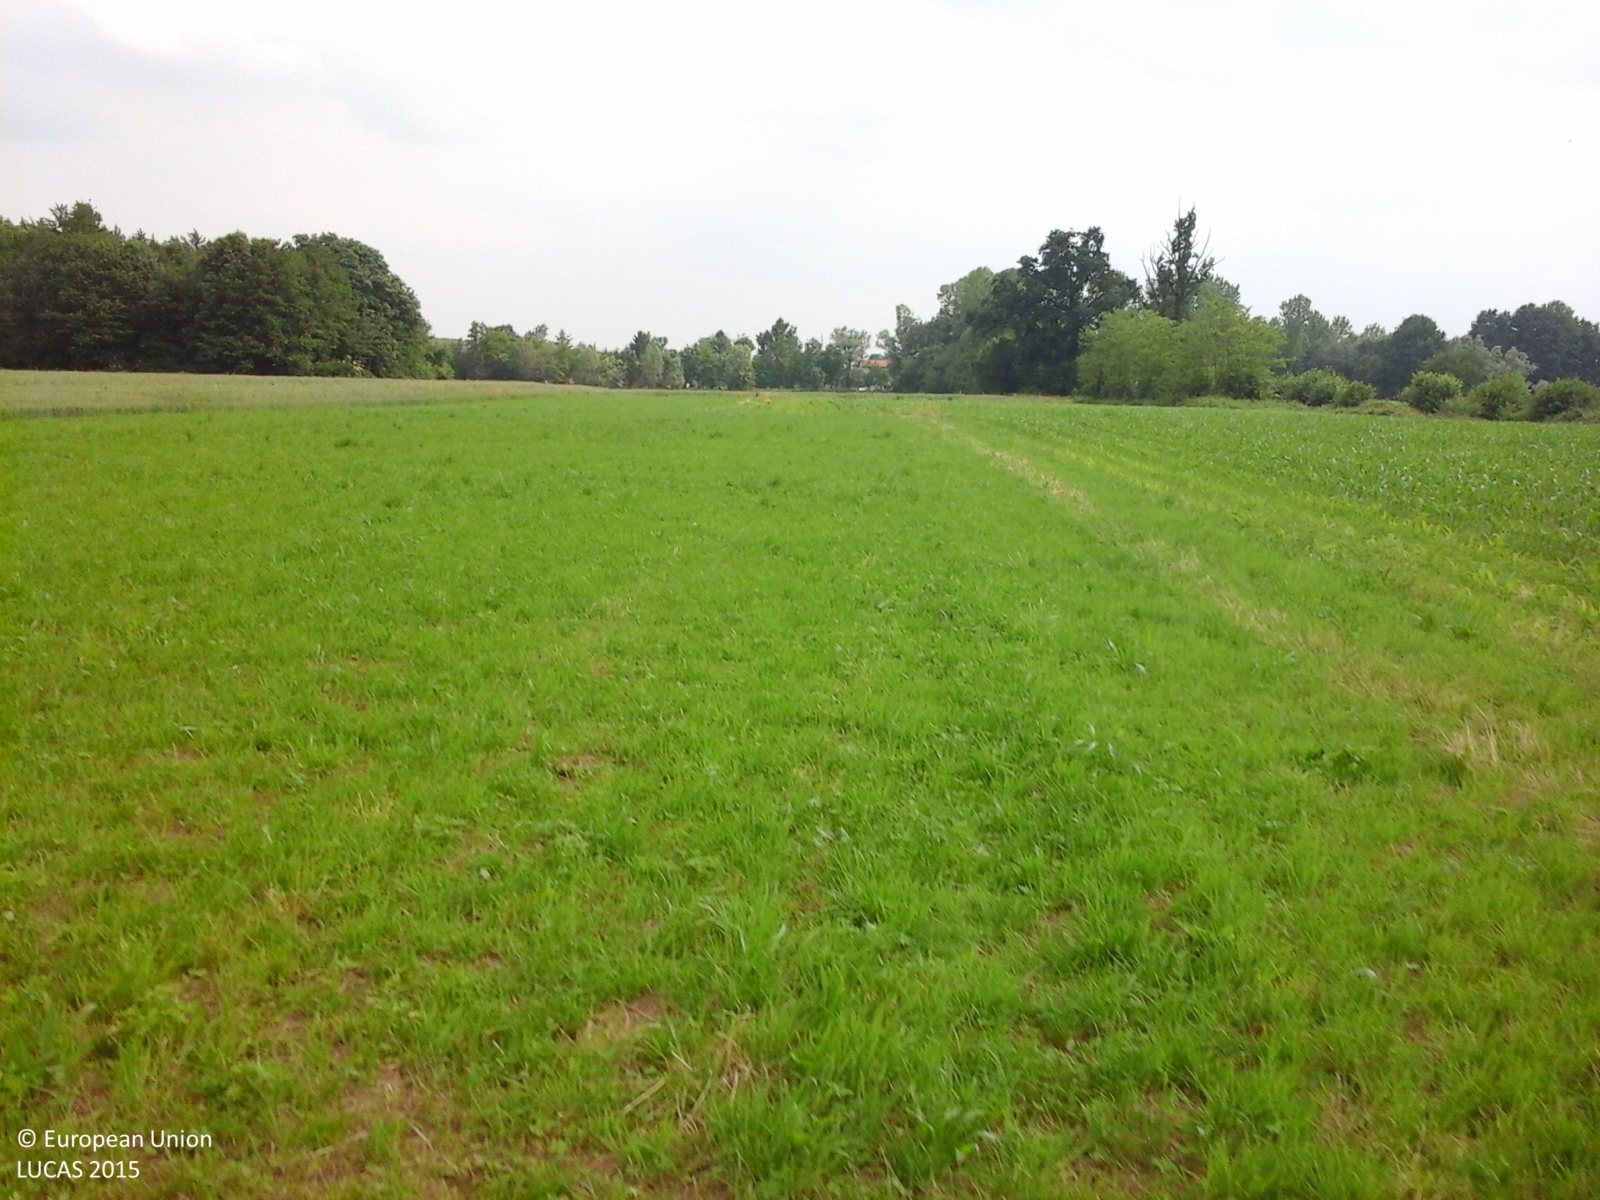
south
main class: Grassland
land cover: Grassland without tree/shrub cover
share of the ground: > 75 %
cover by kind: herbaceous plants 100 %
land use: Agriculture (excluding fallow land and kitchen gardens)
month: May
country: IT
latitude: 45.3721
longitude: 7.7436
